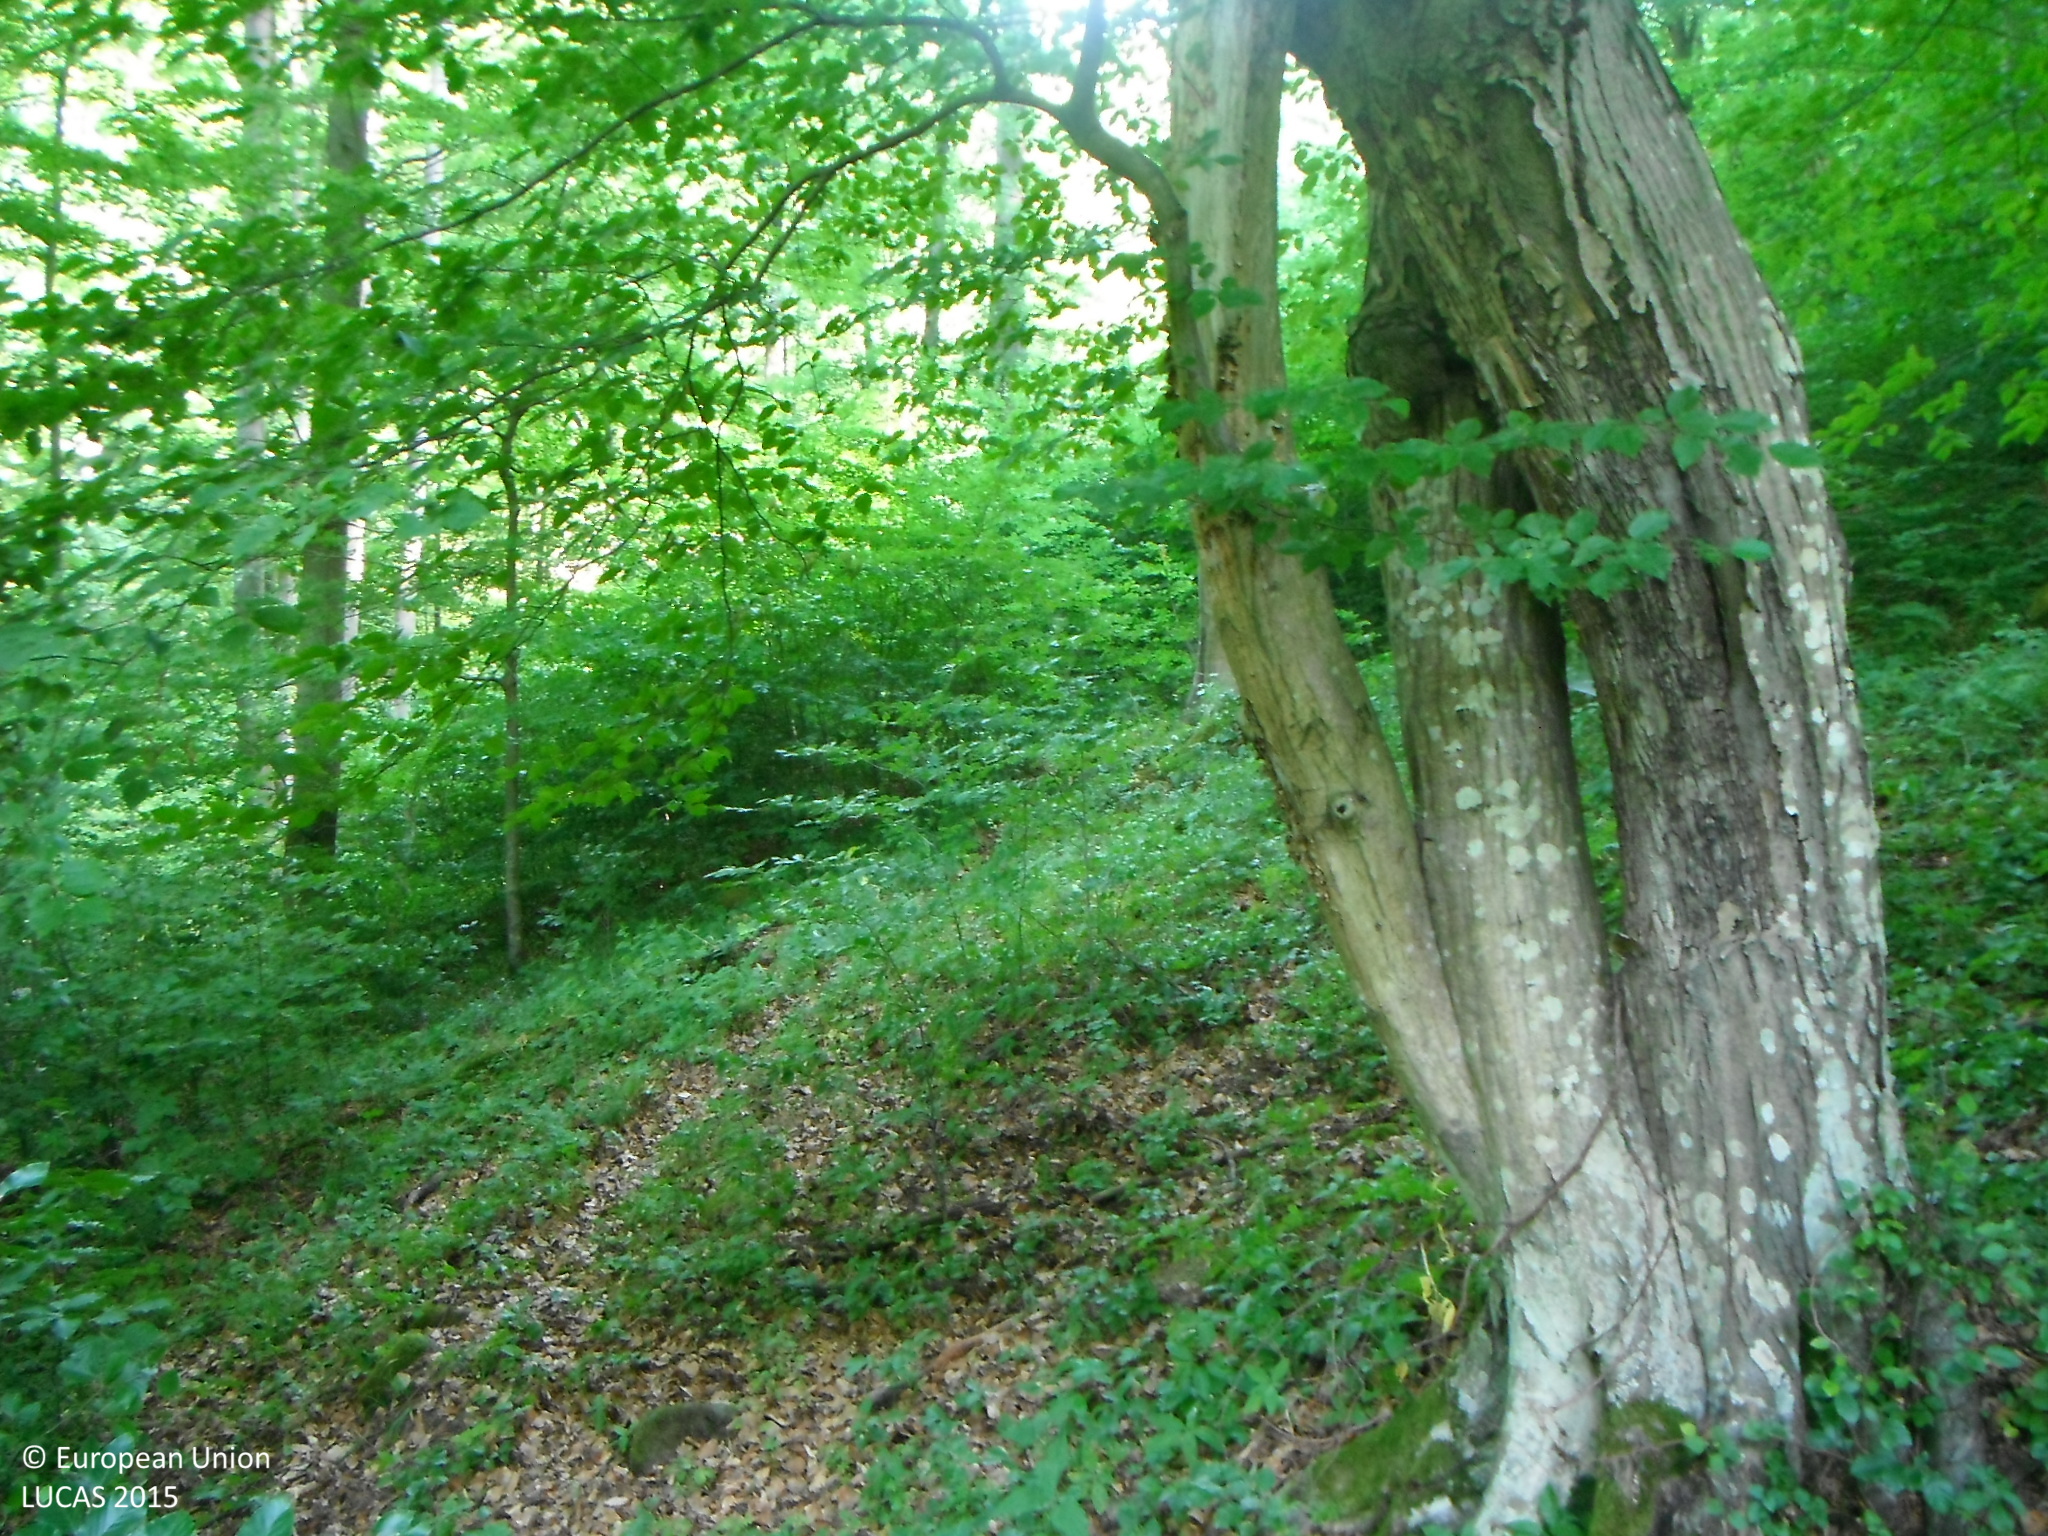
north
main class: Woodland
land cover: Broadleaved woodland
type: beech forest
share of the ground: > 75 %
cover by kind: broadleaved forest trees 90 %, herbaceous plants 10 %
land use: Forestry
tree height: > 5 m
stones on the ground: 25 - 50 %
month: July
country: SK
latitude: 48.5271
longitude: 19.1894
